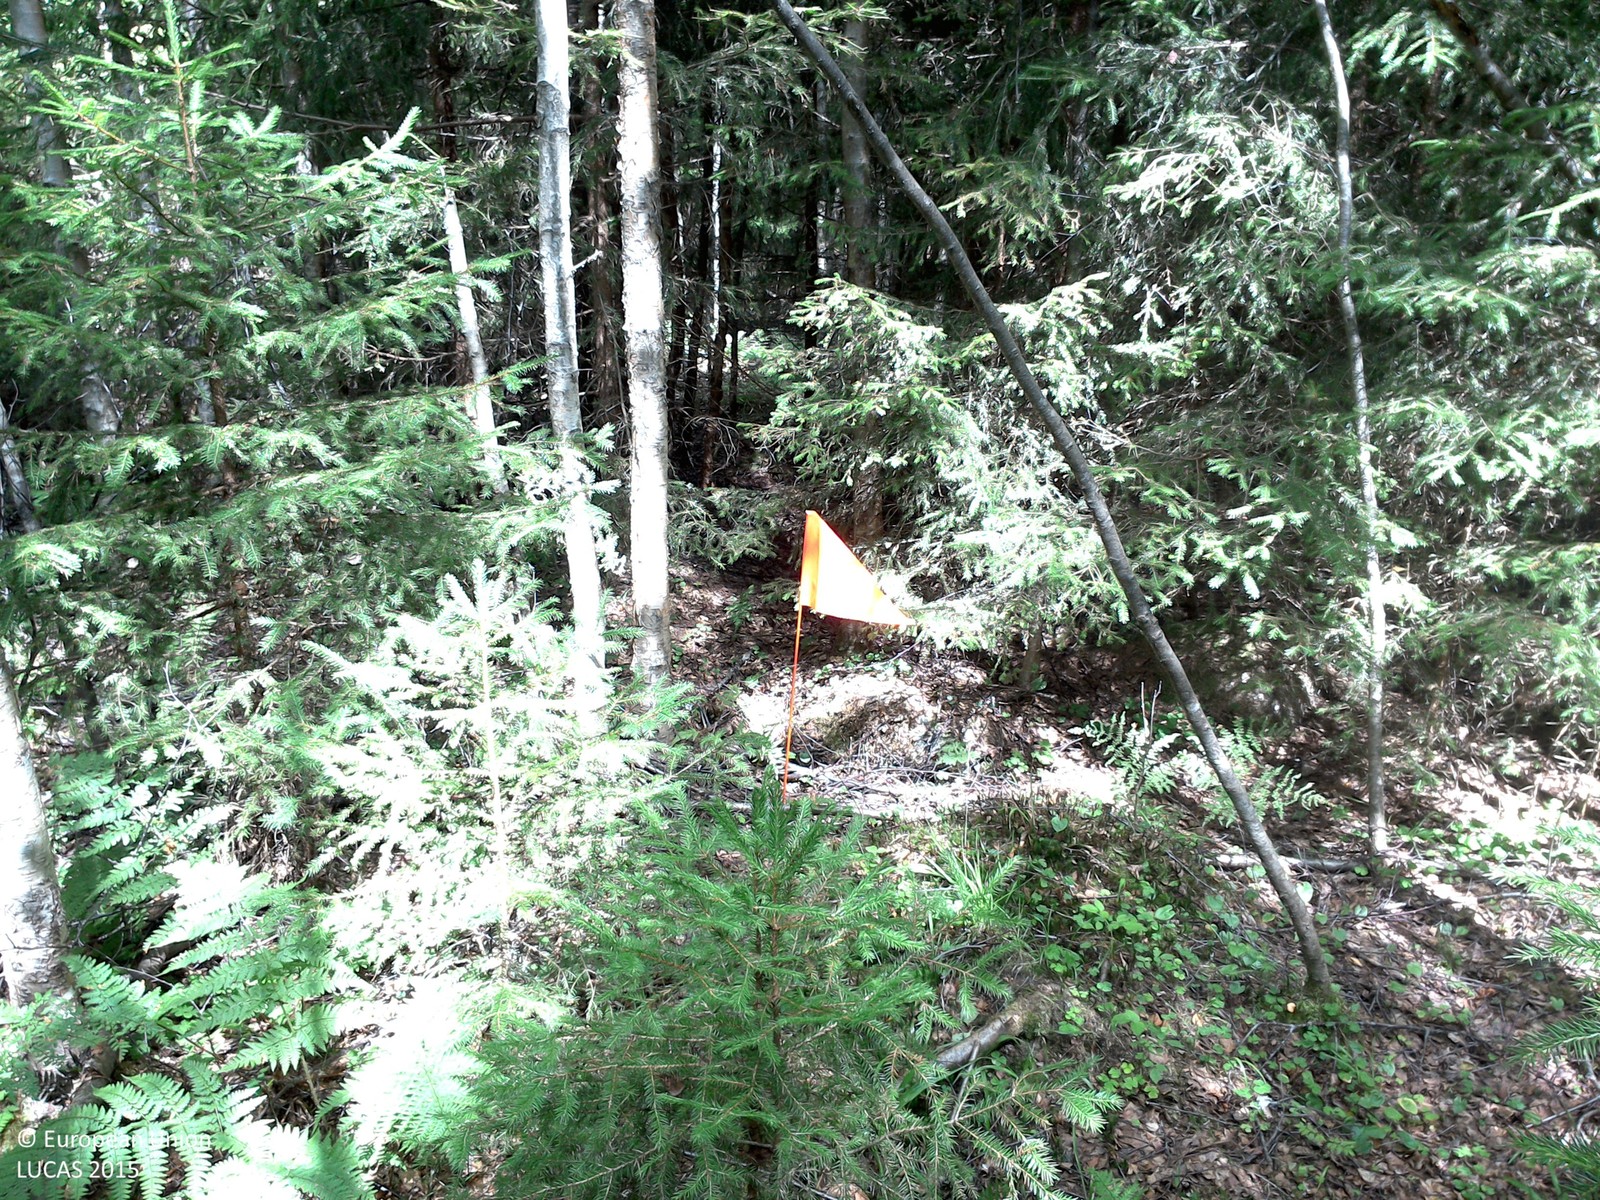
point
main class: Woodland
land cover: Broadleaved woodland
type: boreal forest
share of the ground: > 75 %
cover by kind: broadleaved forest trees 70 %, herbaceous plants 20 %, coniferous forest trees 10 %
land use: Forestry
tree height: > 5 m
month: July
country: SE
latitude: 58.0071
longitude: 14.8177
